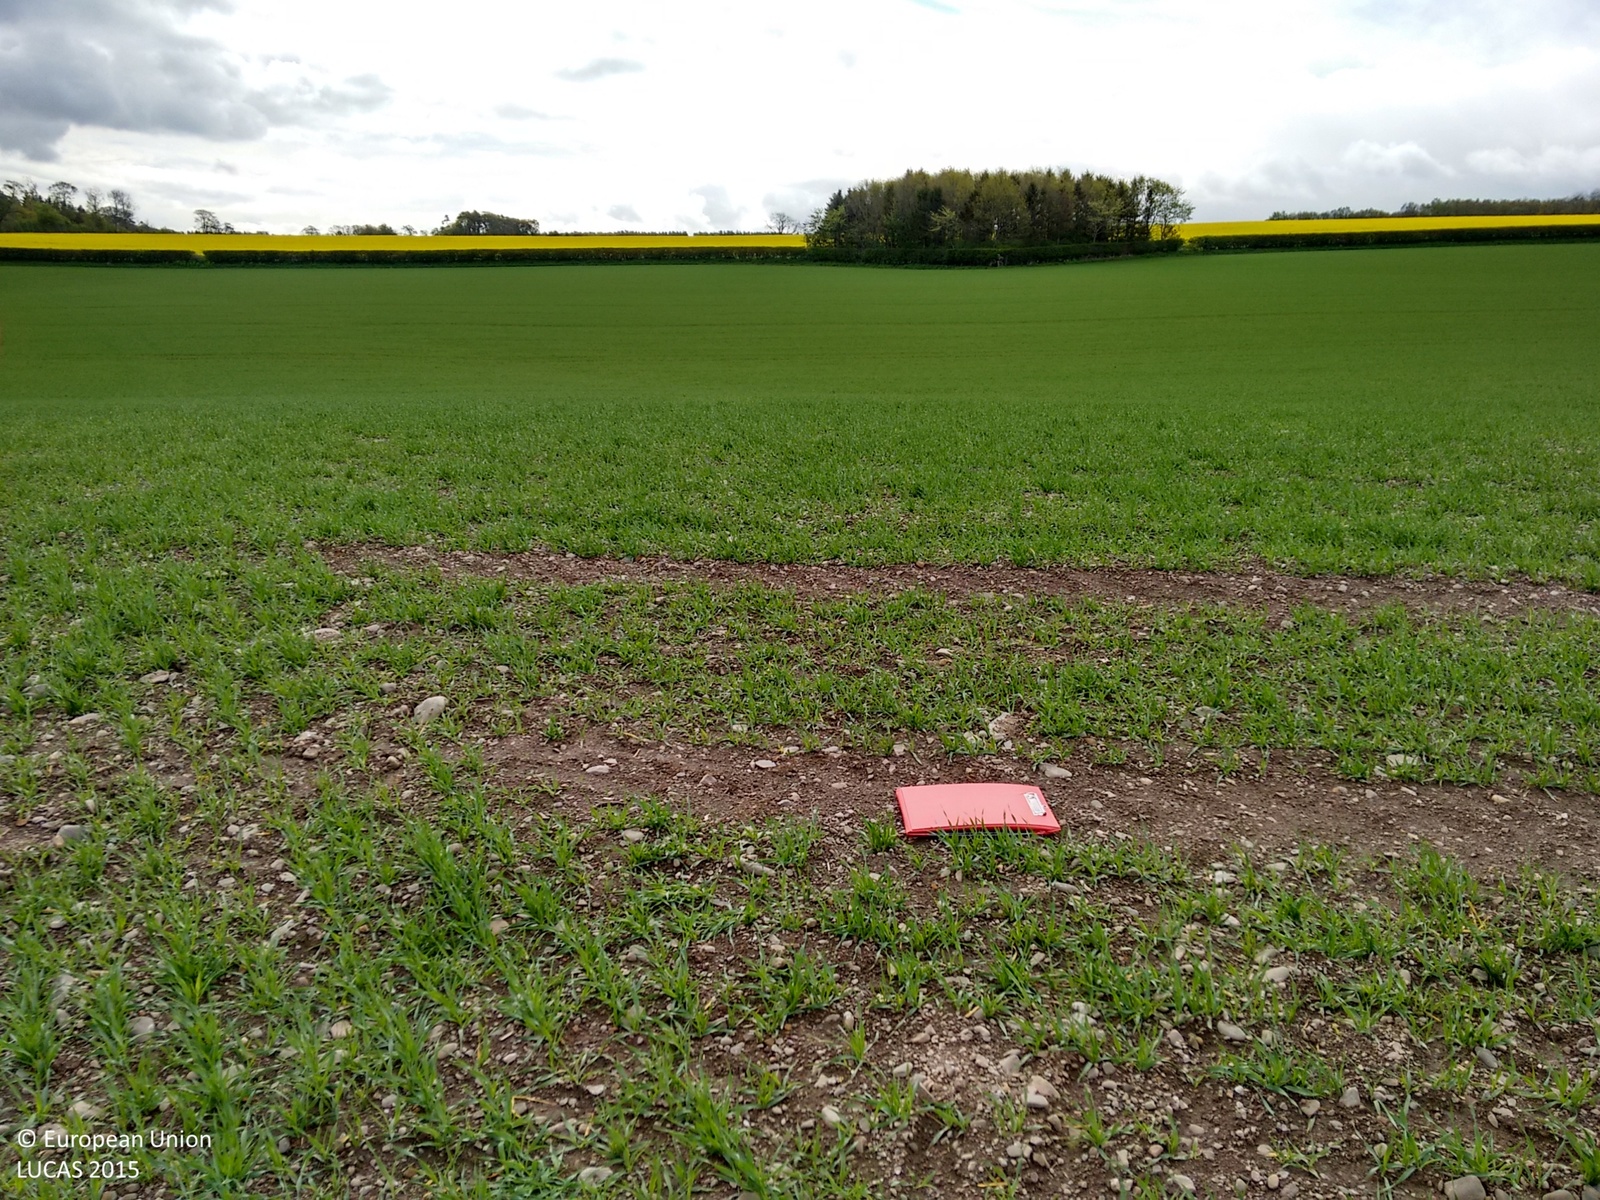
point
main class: Cropland
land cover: Barley
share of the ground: 50 - 75 %
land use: Agriculture (excluding fallow land and kitchen gardens)
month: May
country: GB
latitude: 55.5599
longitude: -2.6360
